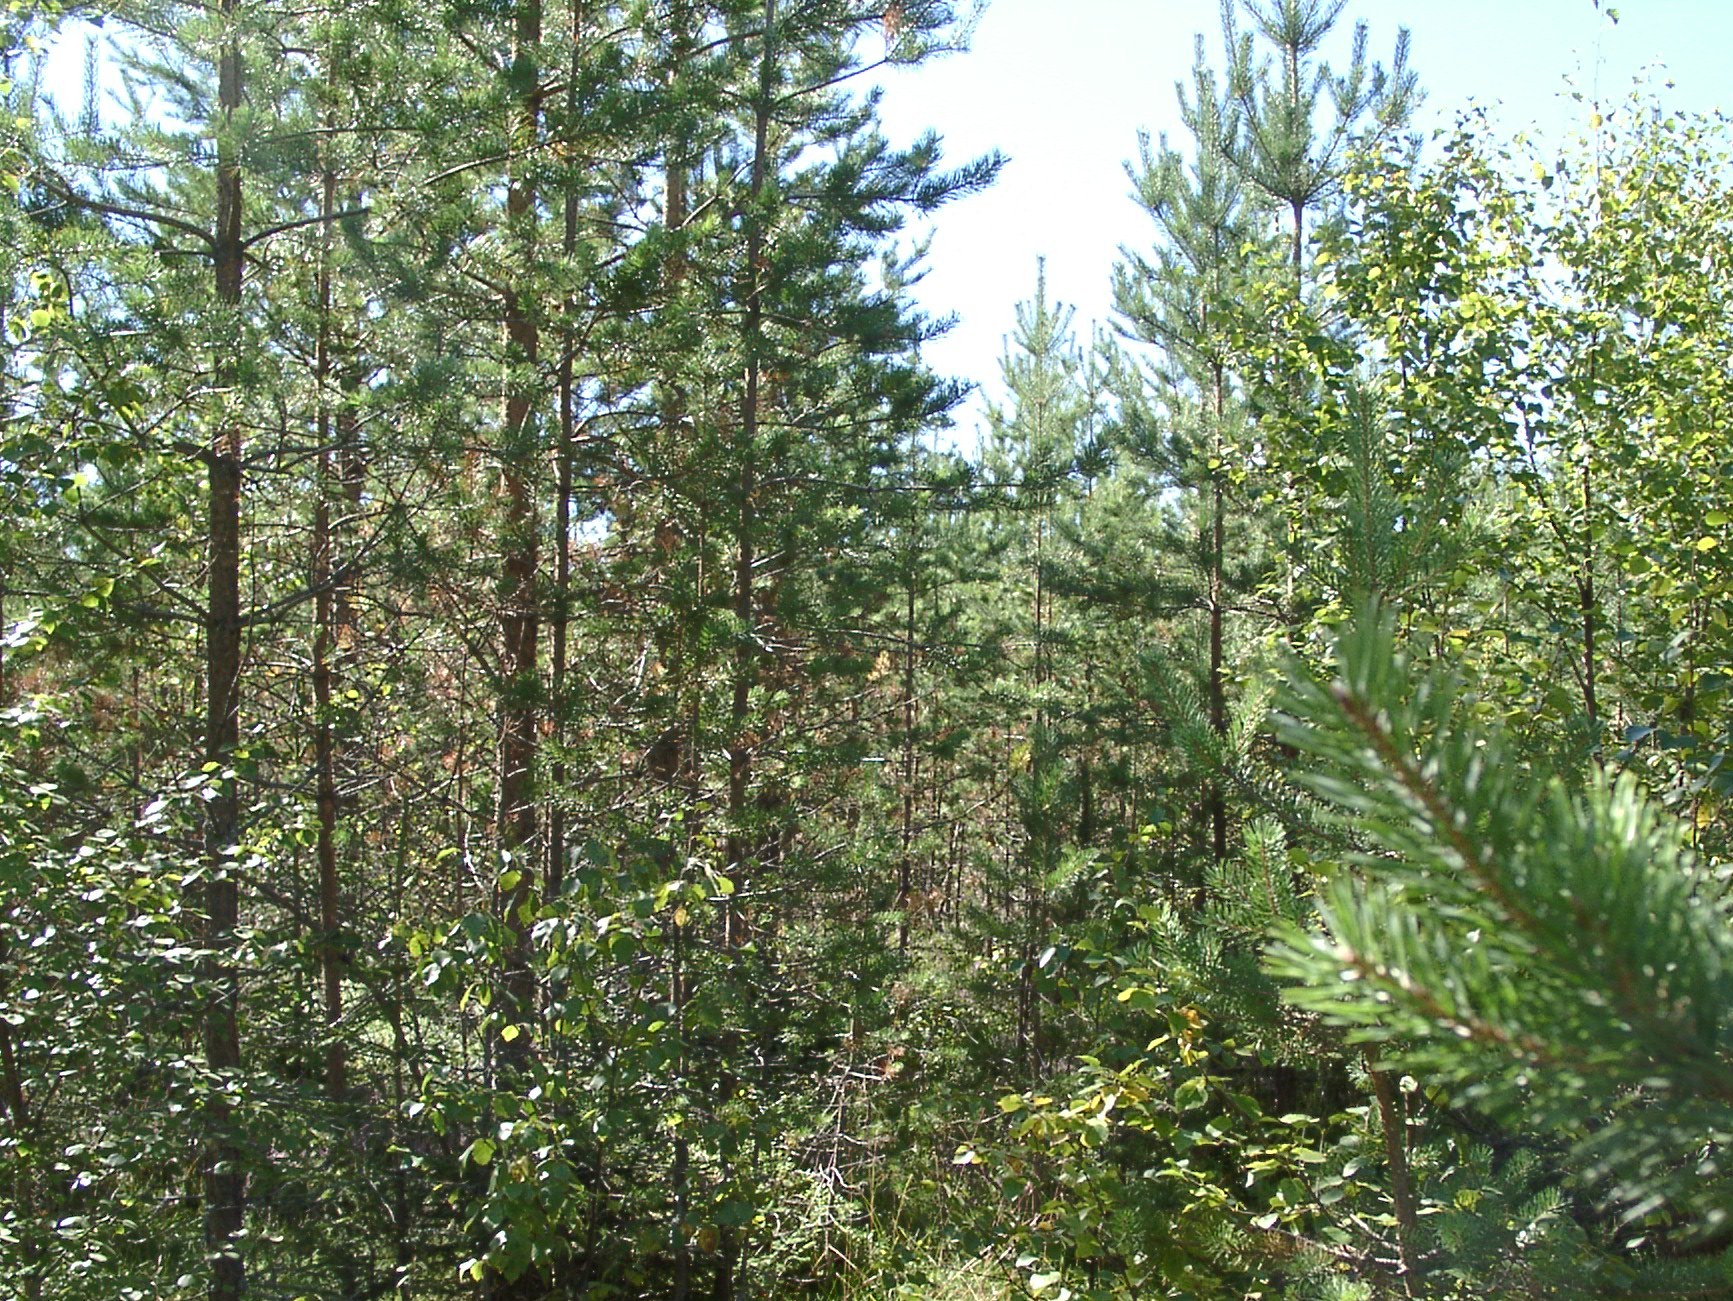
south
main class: Woodland
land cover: Pine dominated mixed woodland
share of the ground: 25 - 50 %
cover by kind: shrubs 25 %, coniferous forest trees 20 %, broadleaved forest trees 10 %, herbaceous plants 10 %, lichens and mosses 5 %
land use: Residential
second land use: Forestry
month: August
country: FI
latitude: 62.4735
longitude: 25.2540
